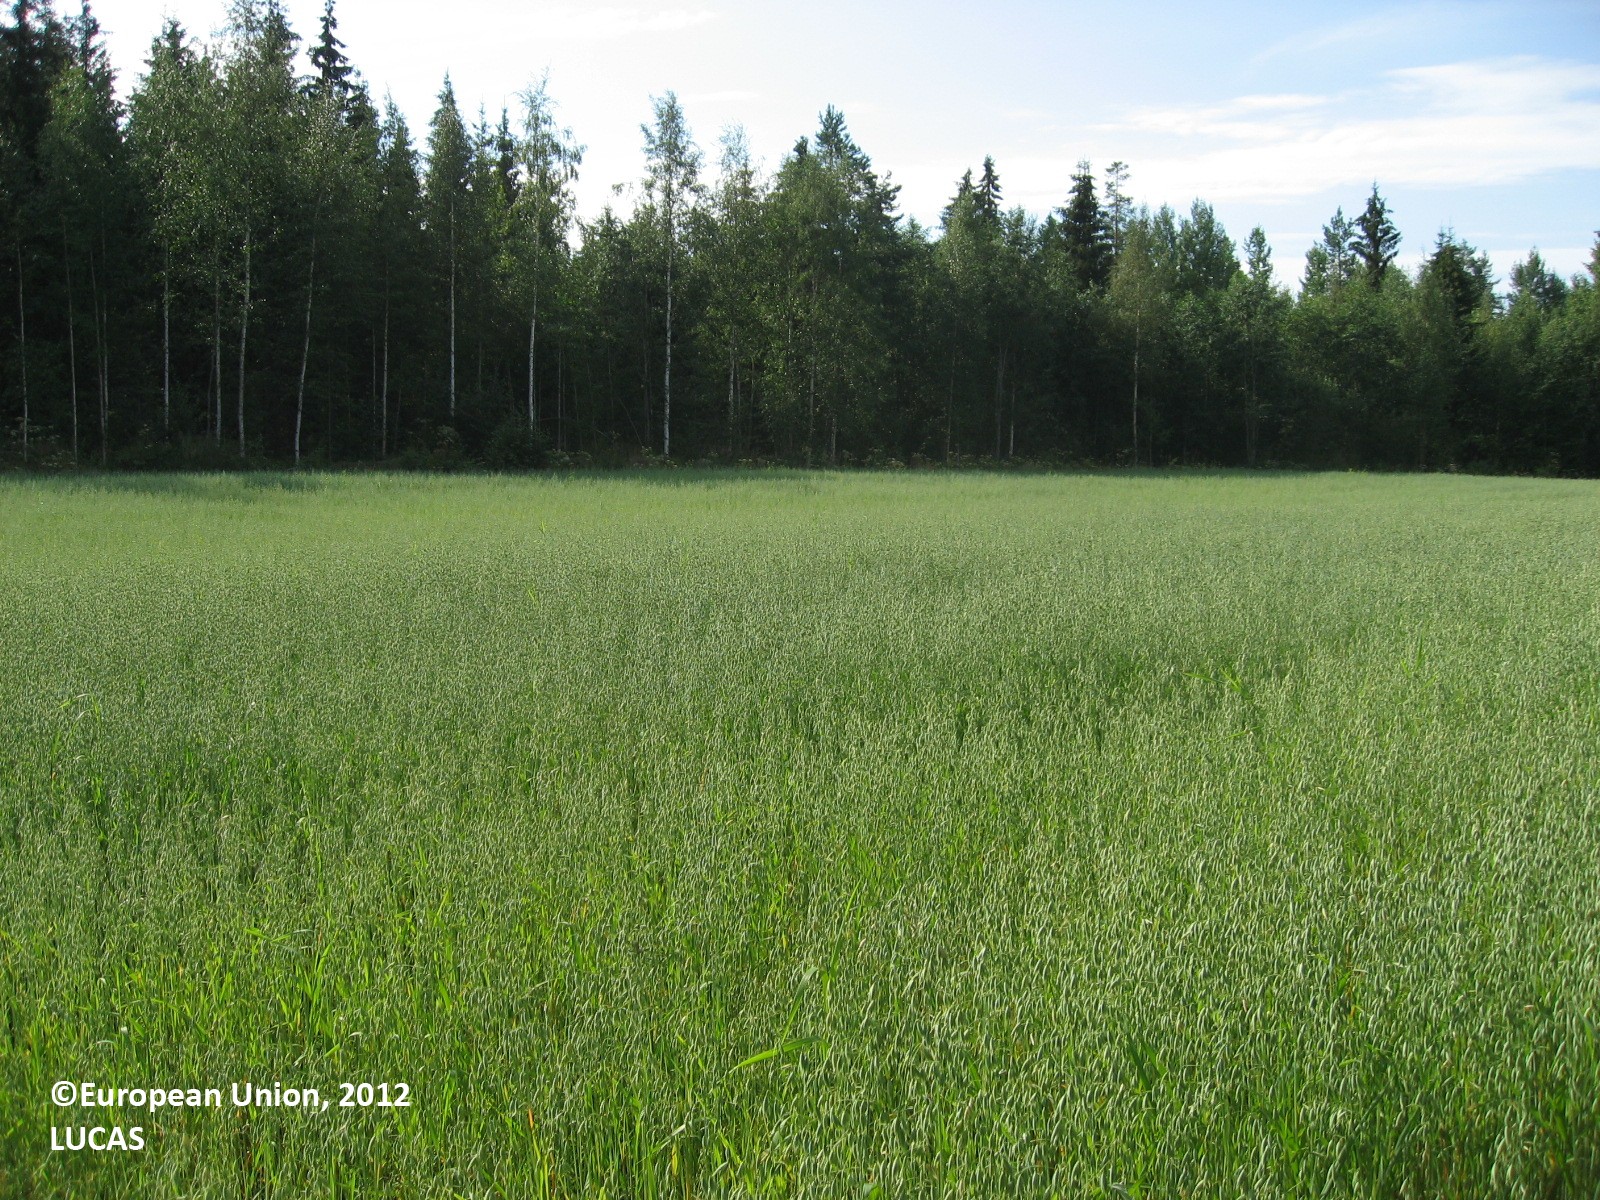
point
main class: Cropland
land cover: Oats
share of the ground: > 75 %
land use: Agriculture (excluding fallow land and kitchen gardens)
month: August
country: FI
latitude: 61.5147
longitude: 25.9392
